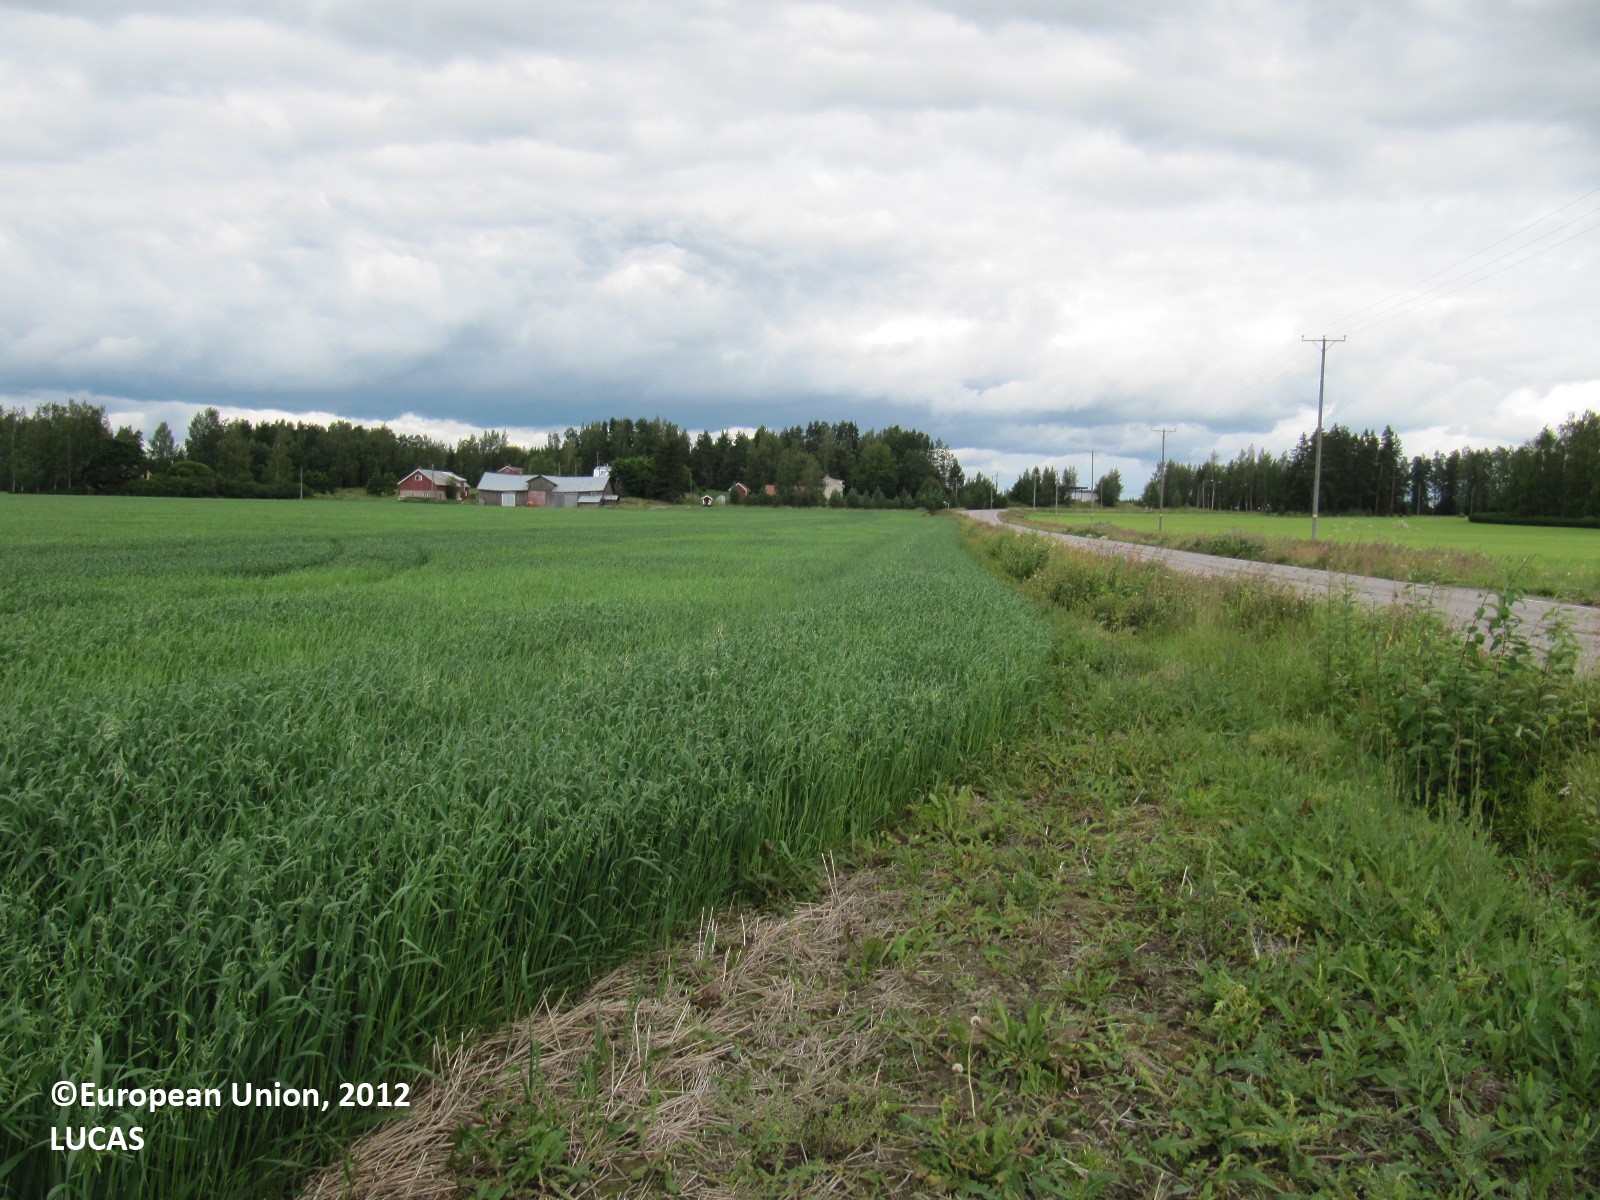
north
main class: Cropland
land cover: Oats
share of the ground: > 75 %
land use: Agriculture (excluding fallow land and kitchen gardens)
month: July
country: FI
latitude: 60.7847
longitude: 24.6727
